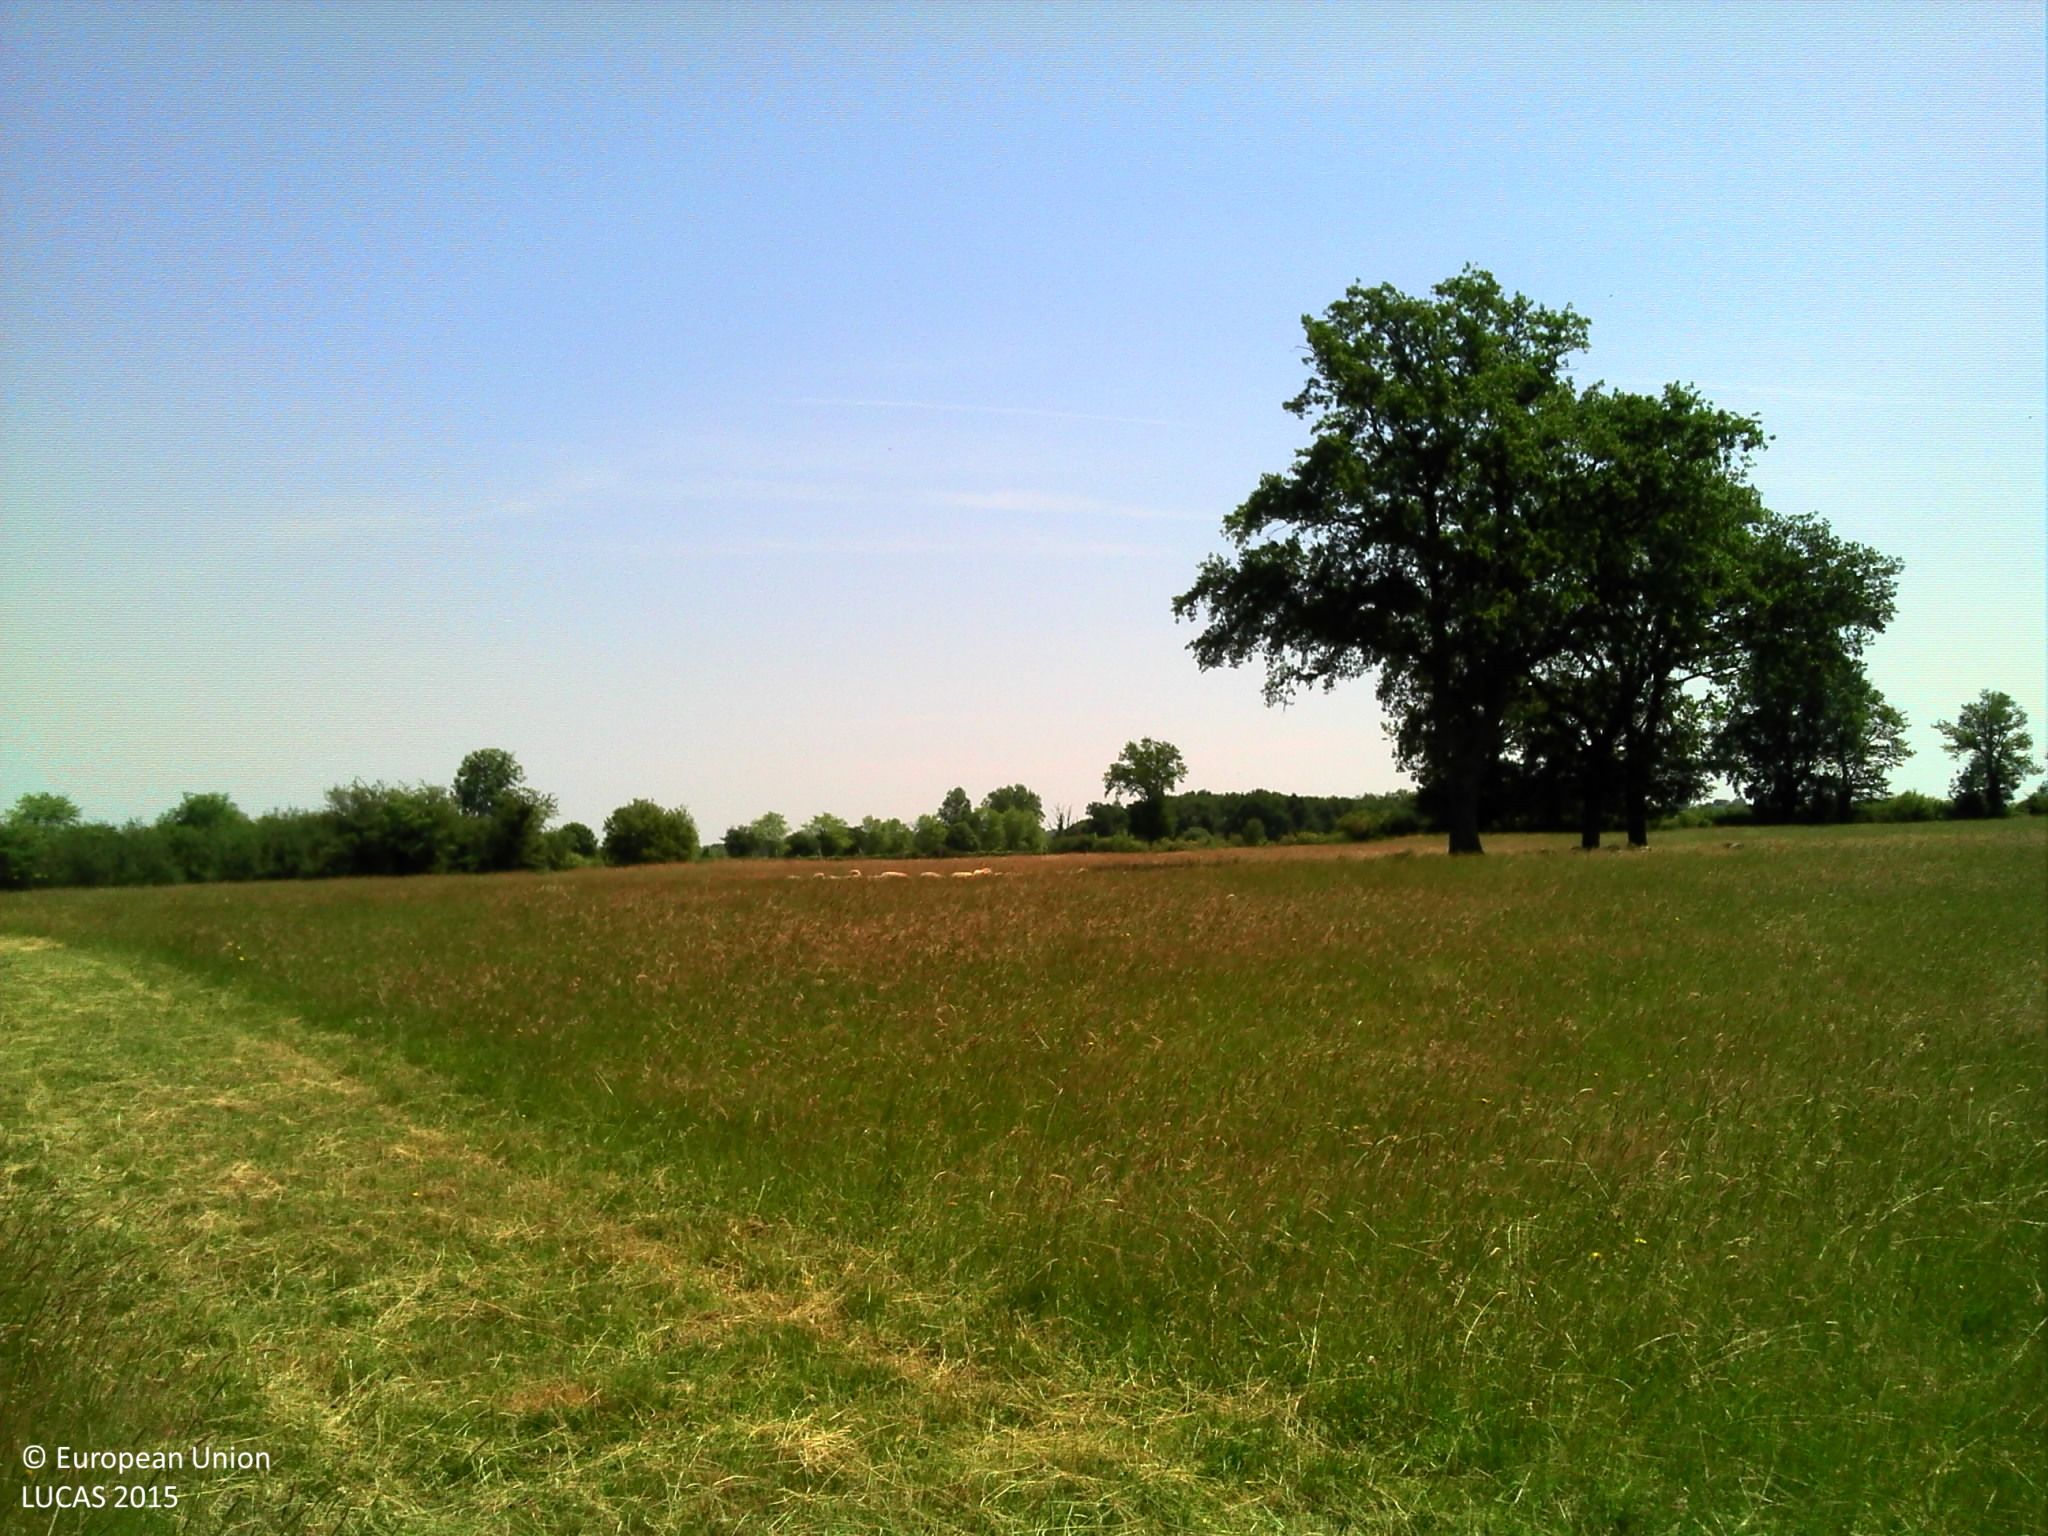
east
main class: Grassland
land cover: Grassland without tree/shrub cover
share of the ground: > 75 %
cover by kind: herbaceous plants 100 %
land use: Agriculture (excluding fallow land and kitchen gardens)
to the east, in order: Grassland without tree/shrub cover; Fences; Ditches and canals; Grassland without tree/shrub cover; Single bushes/trees; Grassland without tree/shrub cover
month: June
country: FR
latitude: 46.2888
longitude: 2.7930
